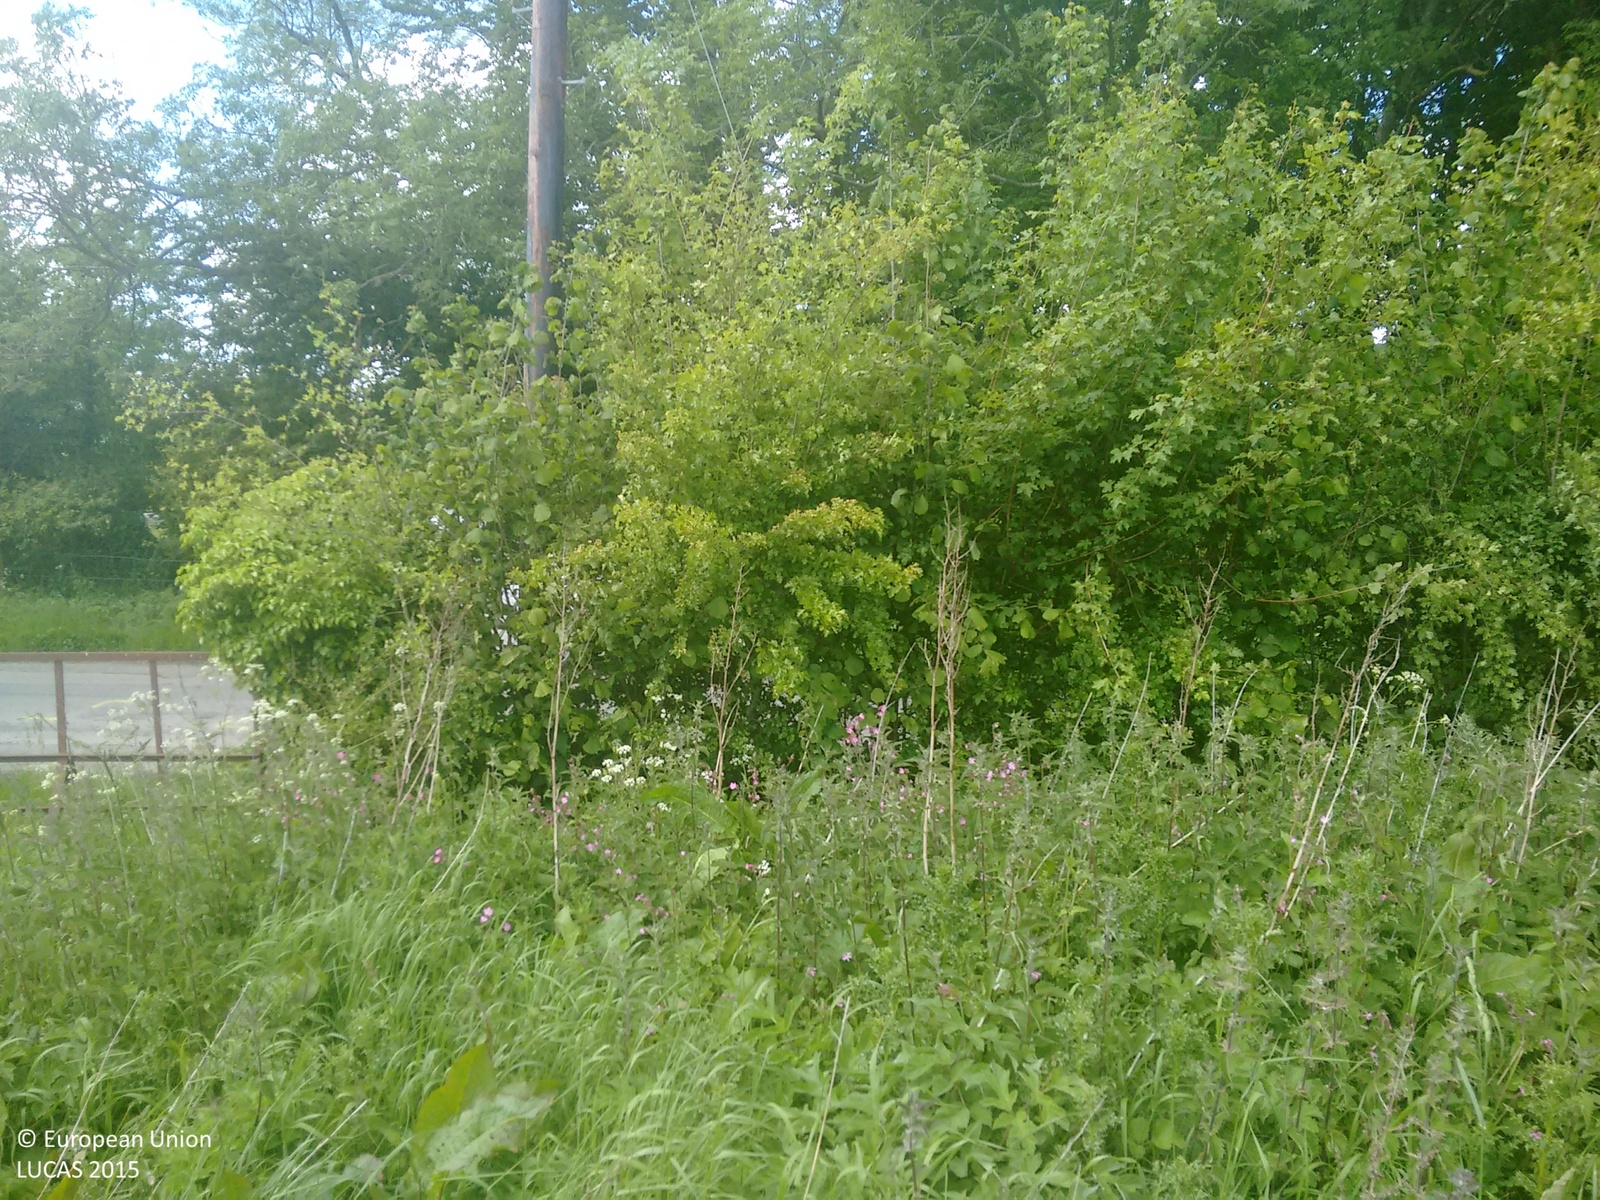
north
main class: Cropland
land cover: Common wheat
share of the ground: > 75 %
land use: Agriculture (excluding fallow land and kitchen gardens)
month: June
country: GB
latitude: 50.9920
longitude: -2.0988
